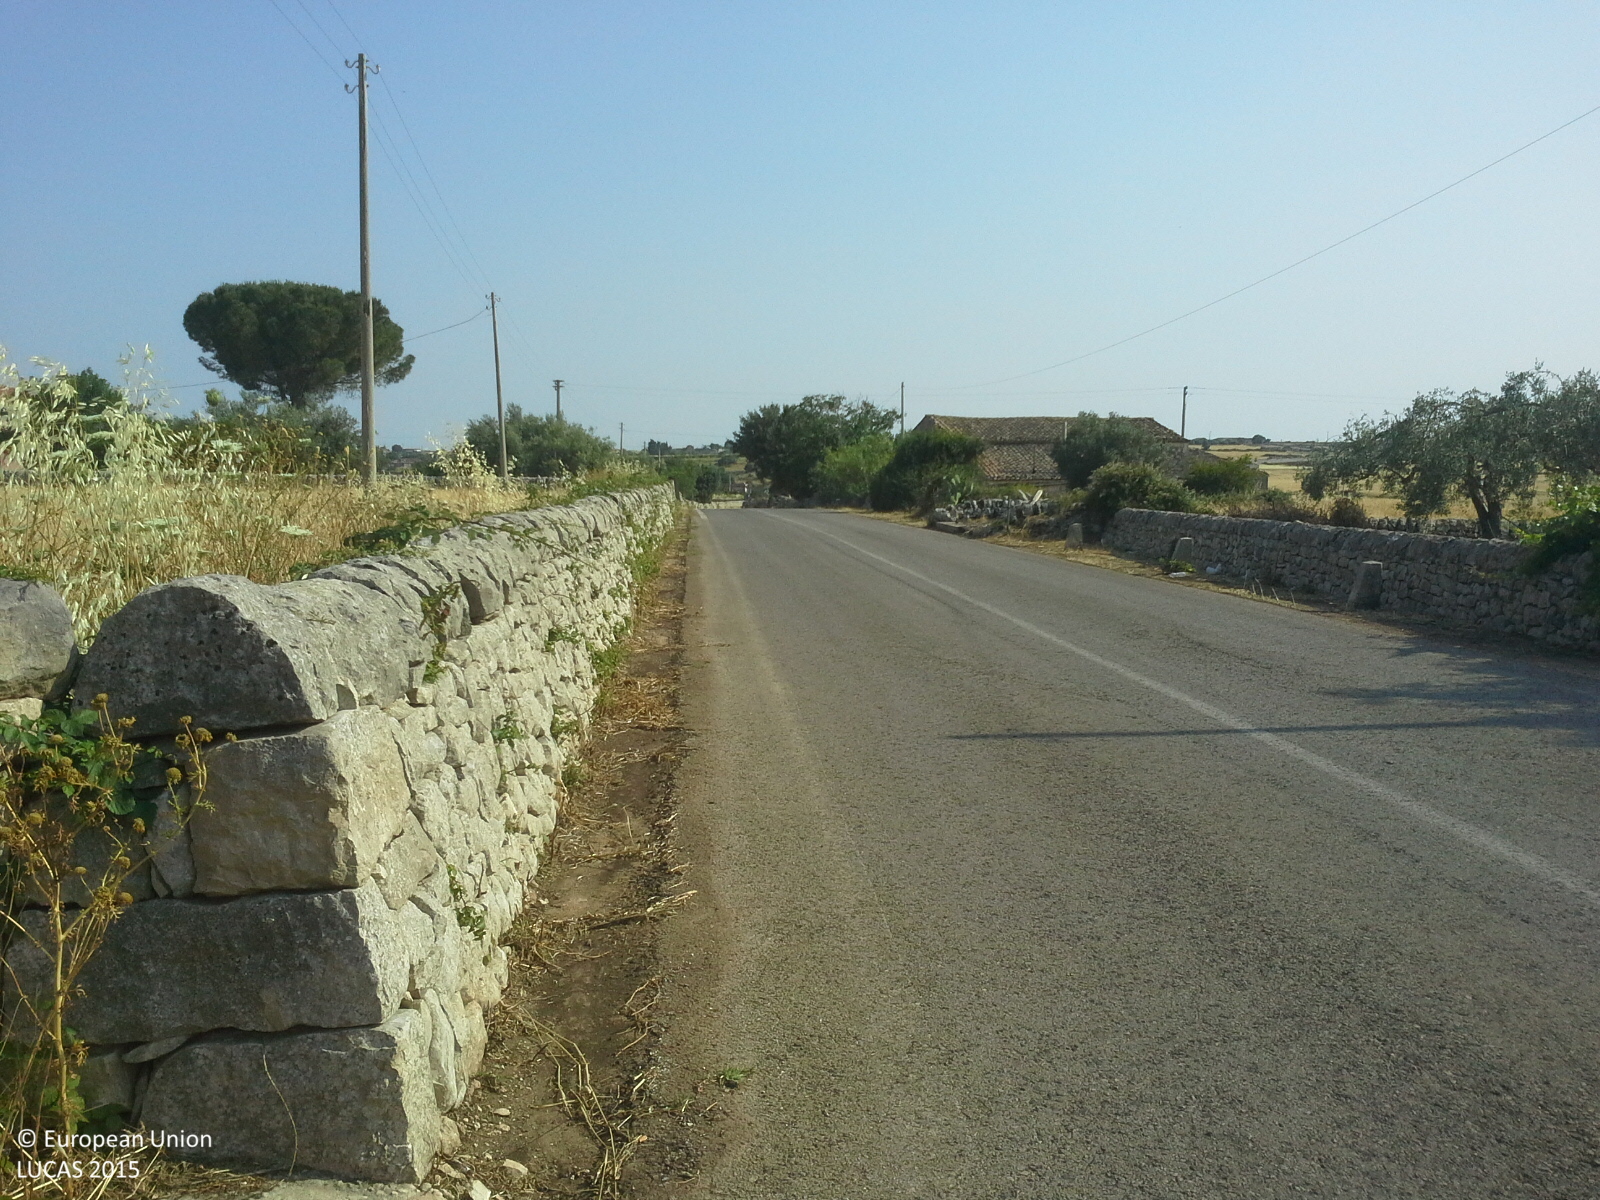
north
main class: Cropland
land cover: Durum wheat
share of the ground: > 75 %
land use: Agriculture (excluding fallow land and kitchen gardens)
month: June
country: IT
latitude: 36.8591
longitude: 14.8628
